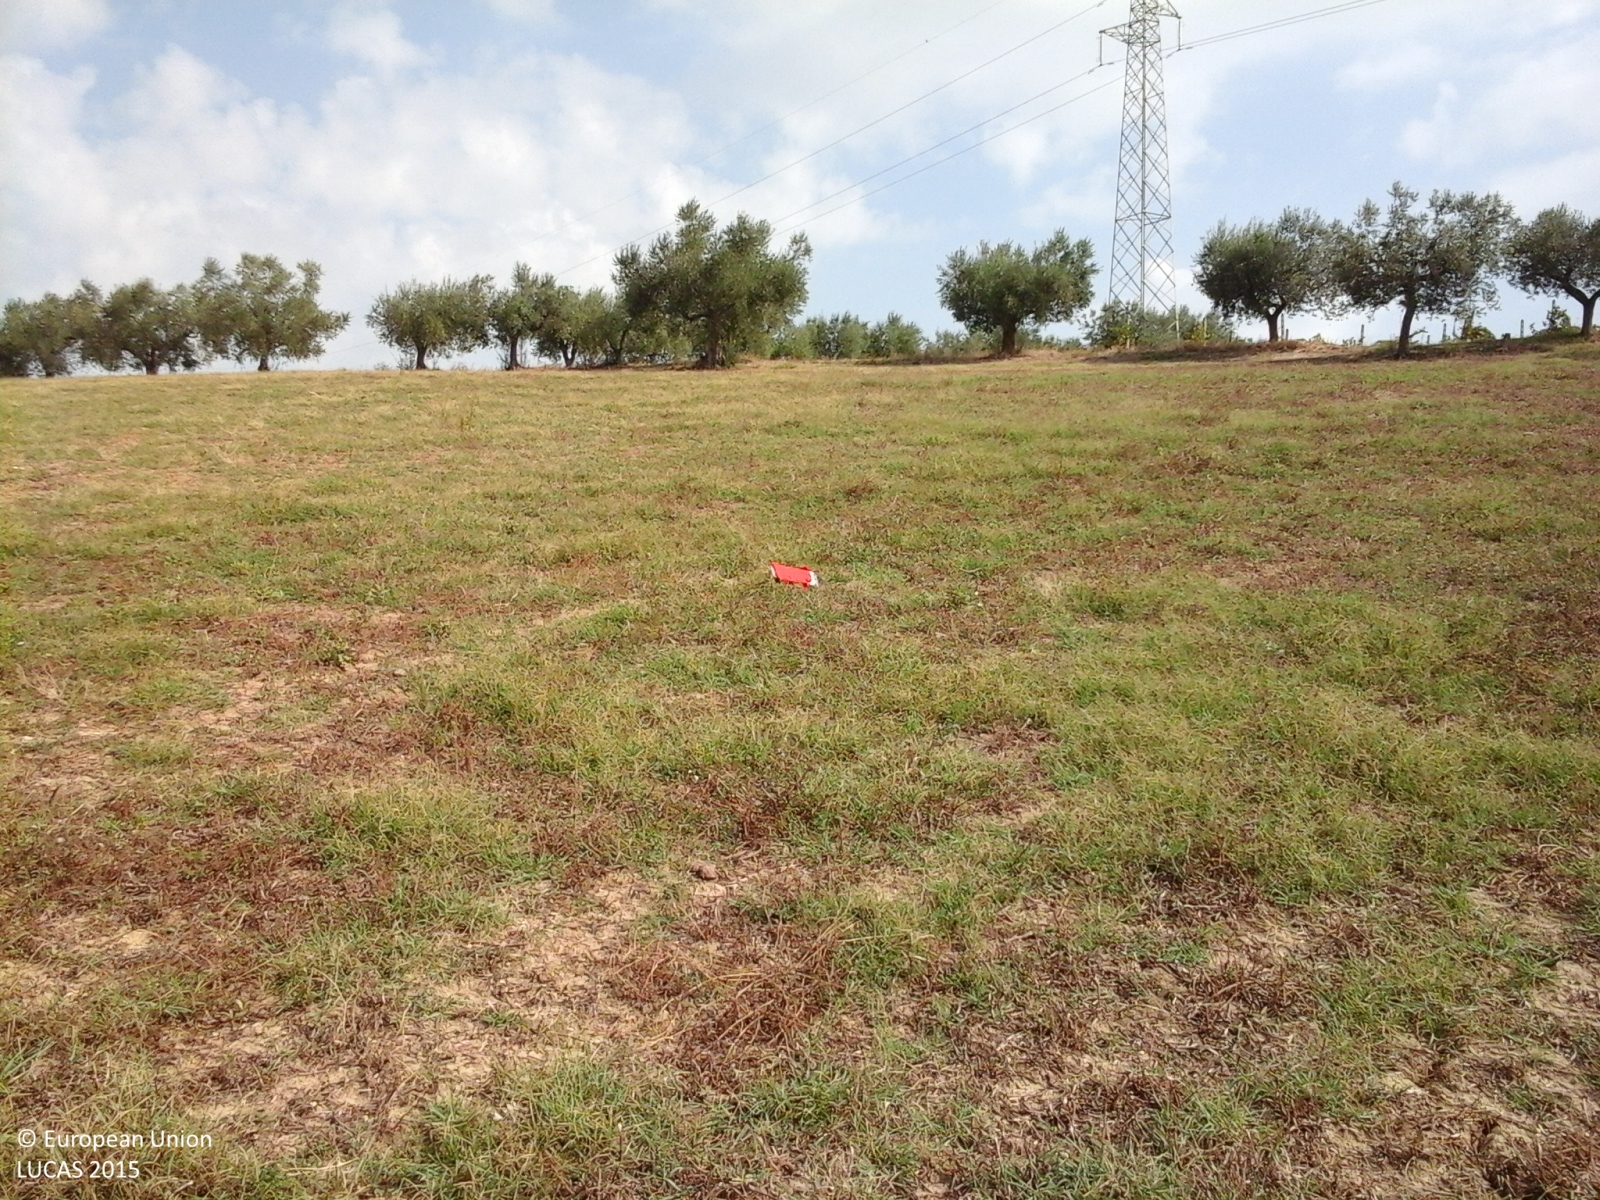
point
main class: Grassland
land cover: Spontaneously vegetated surfaces
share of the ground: > 75 %
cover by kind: herbaceous plants 100 %
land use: Agriculture (excluding fallow land and kitchen gardens)
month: August
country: IT
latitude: 42.7584
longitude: 13.9357
